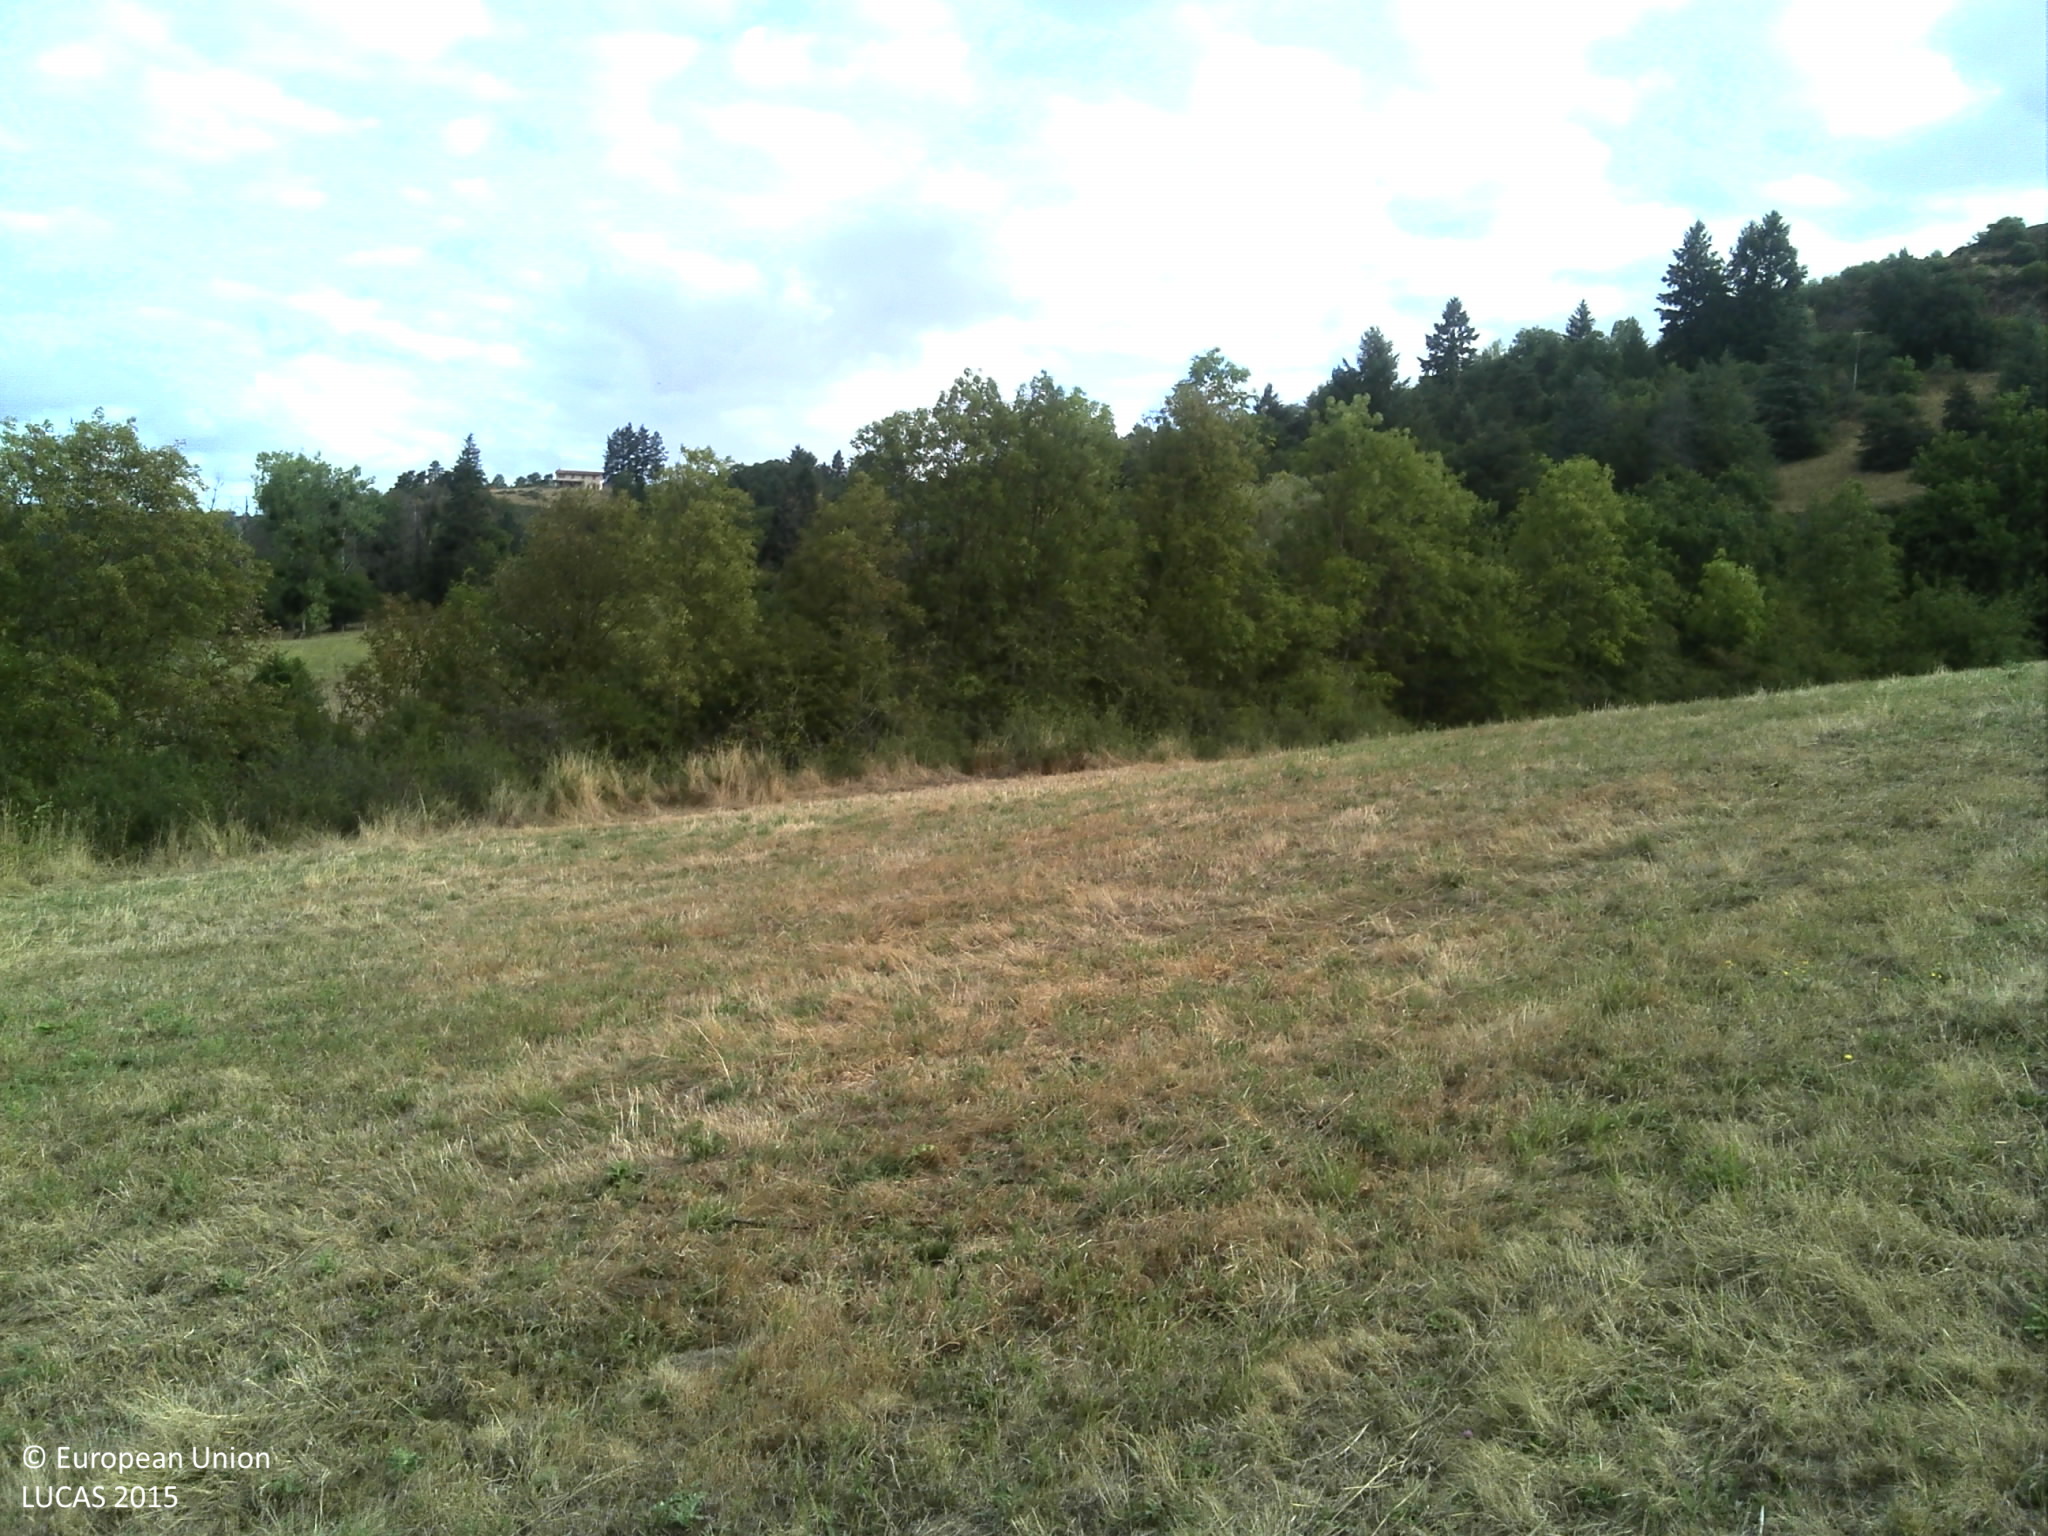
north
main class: Grassland
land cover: Grassland without tree/shrub cover
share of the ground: > 75 %
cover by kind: herbaceous plants 100 %
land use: Agriculture (excluding fallow land and kitchen gardens)
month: July
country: FR
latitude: 45.8821
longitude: 4.1136
